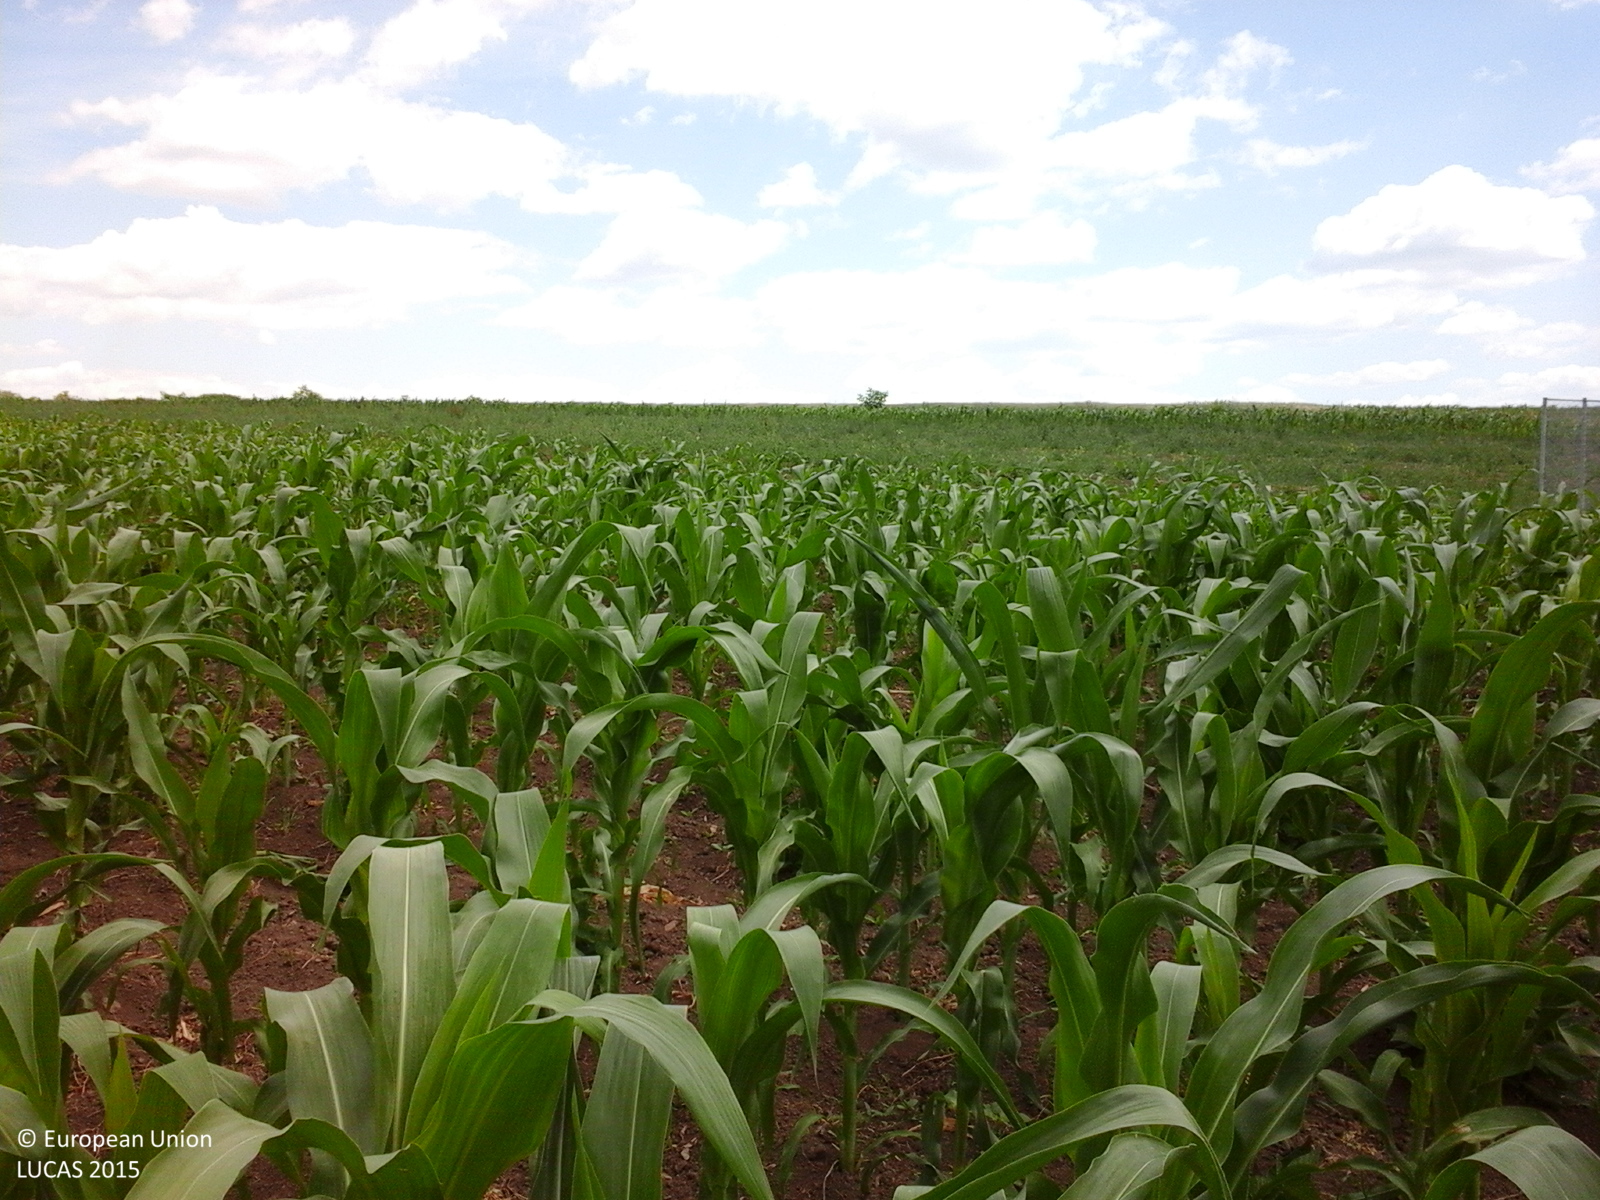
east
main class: Cropland
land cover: Maize
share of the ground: 50 - 75 %
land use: Agriculture (excluding fallow land and kitchen gardens)
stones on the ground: < 10 %
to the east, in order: Maize; Grassland without tree/shrub cover; Maize; Grassland without tree/shrub cover; Lucerne; Common wheat; Maize; Potatoes; Sunflower; Maize; Grassland without tree/shrub cover
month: June
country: RO
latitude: 47.6539
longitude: 26.3420
